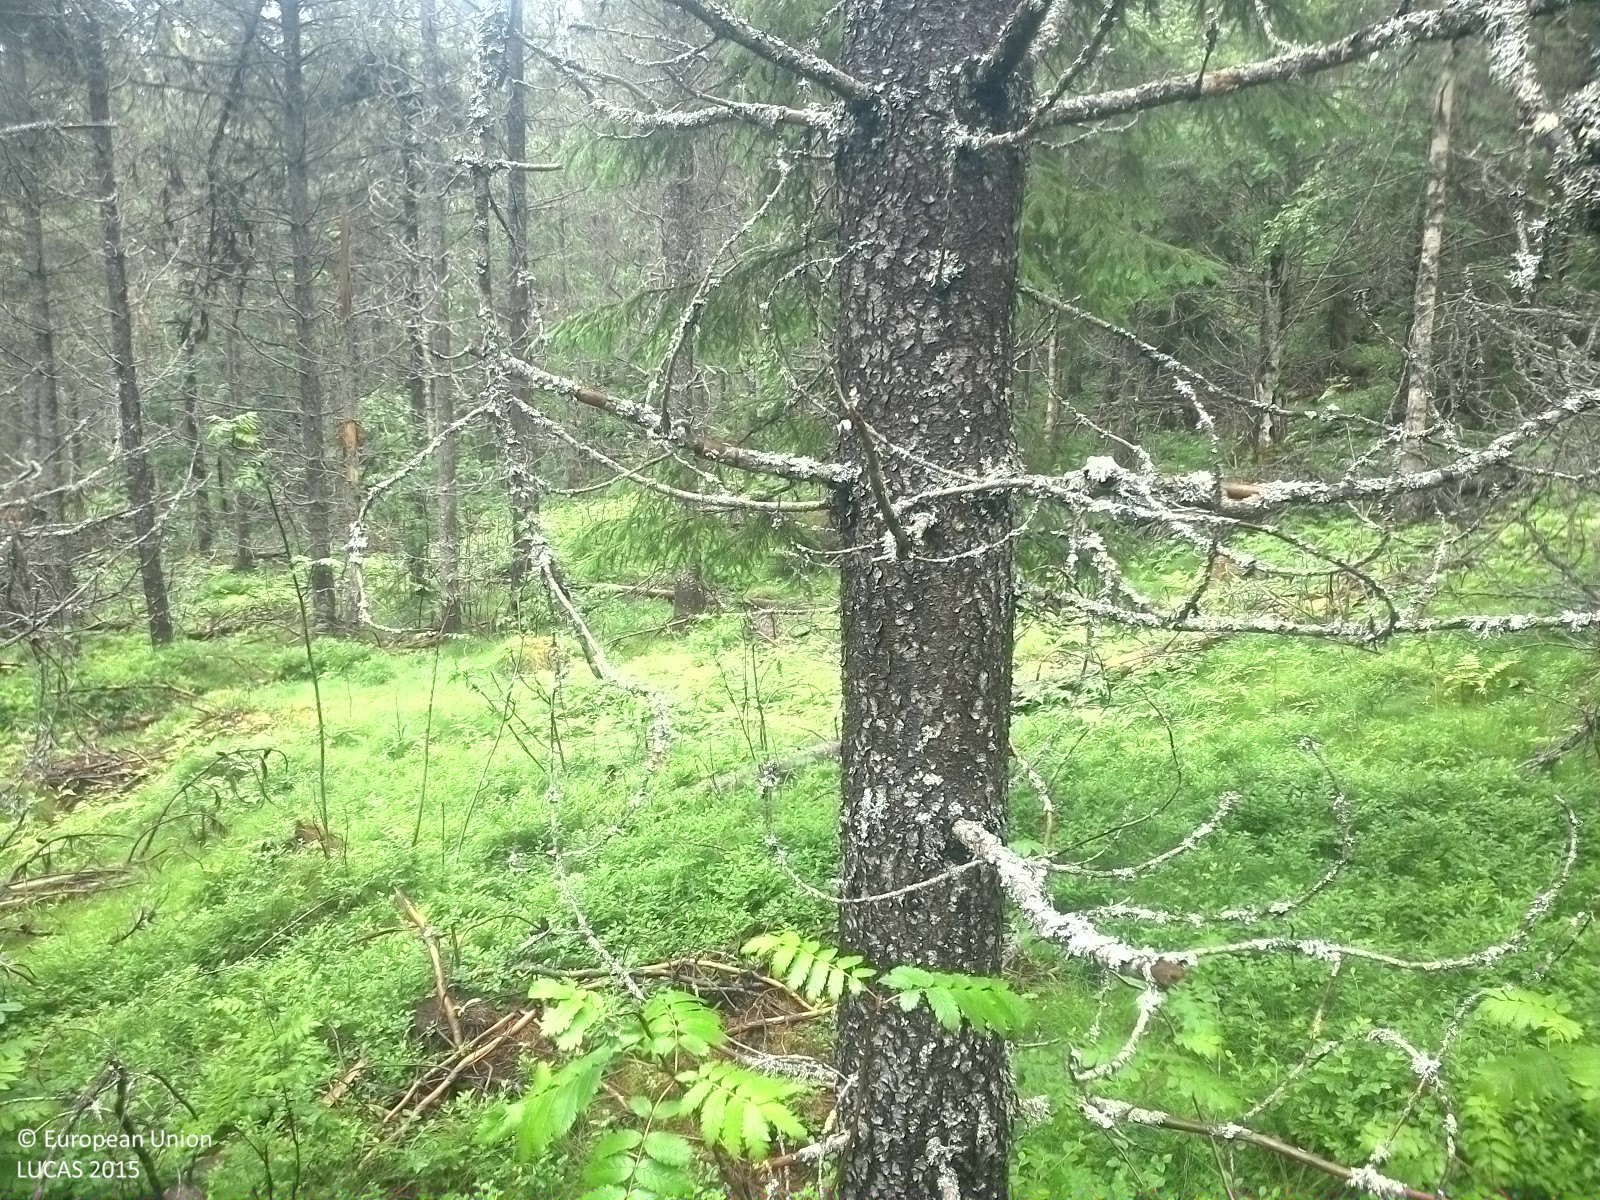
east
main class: Woodland
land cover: Pine dominated coniferous woodland
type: exotic forest
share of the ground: 25 - 50 %
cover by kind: coniferous forest trees 45 %, shrubs 45 %, broadleaved forest trees 5 %, herbaceous plants 5 %
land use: Forestry
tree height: > 5 m
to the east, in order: Pine dominated coniferous woodland; Spruce dominated mixed woodland; Pine dominated coniferous woodland
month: July
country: SE
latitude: 62.5115
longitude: 16.8345
